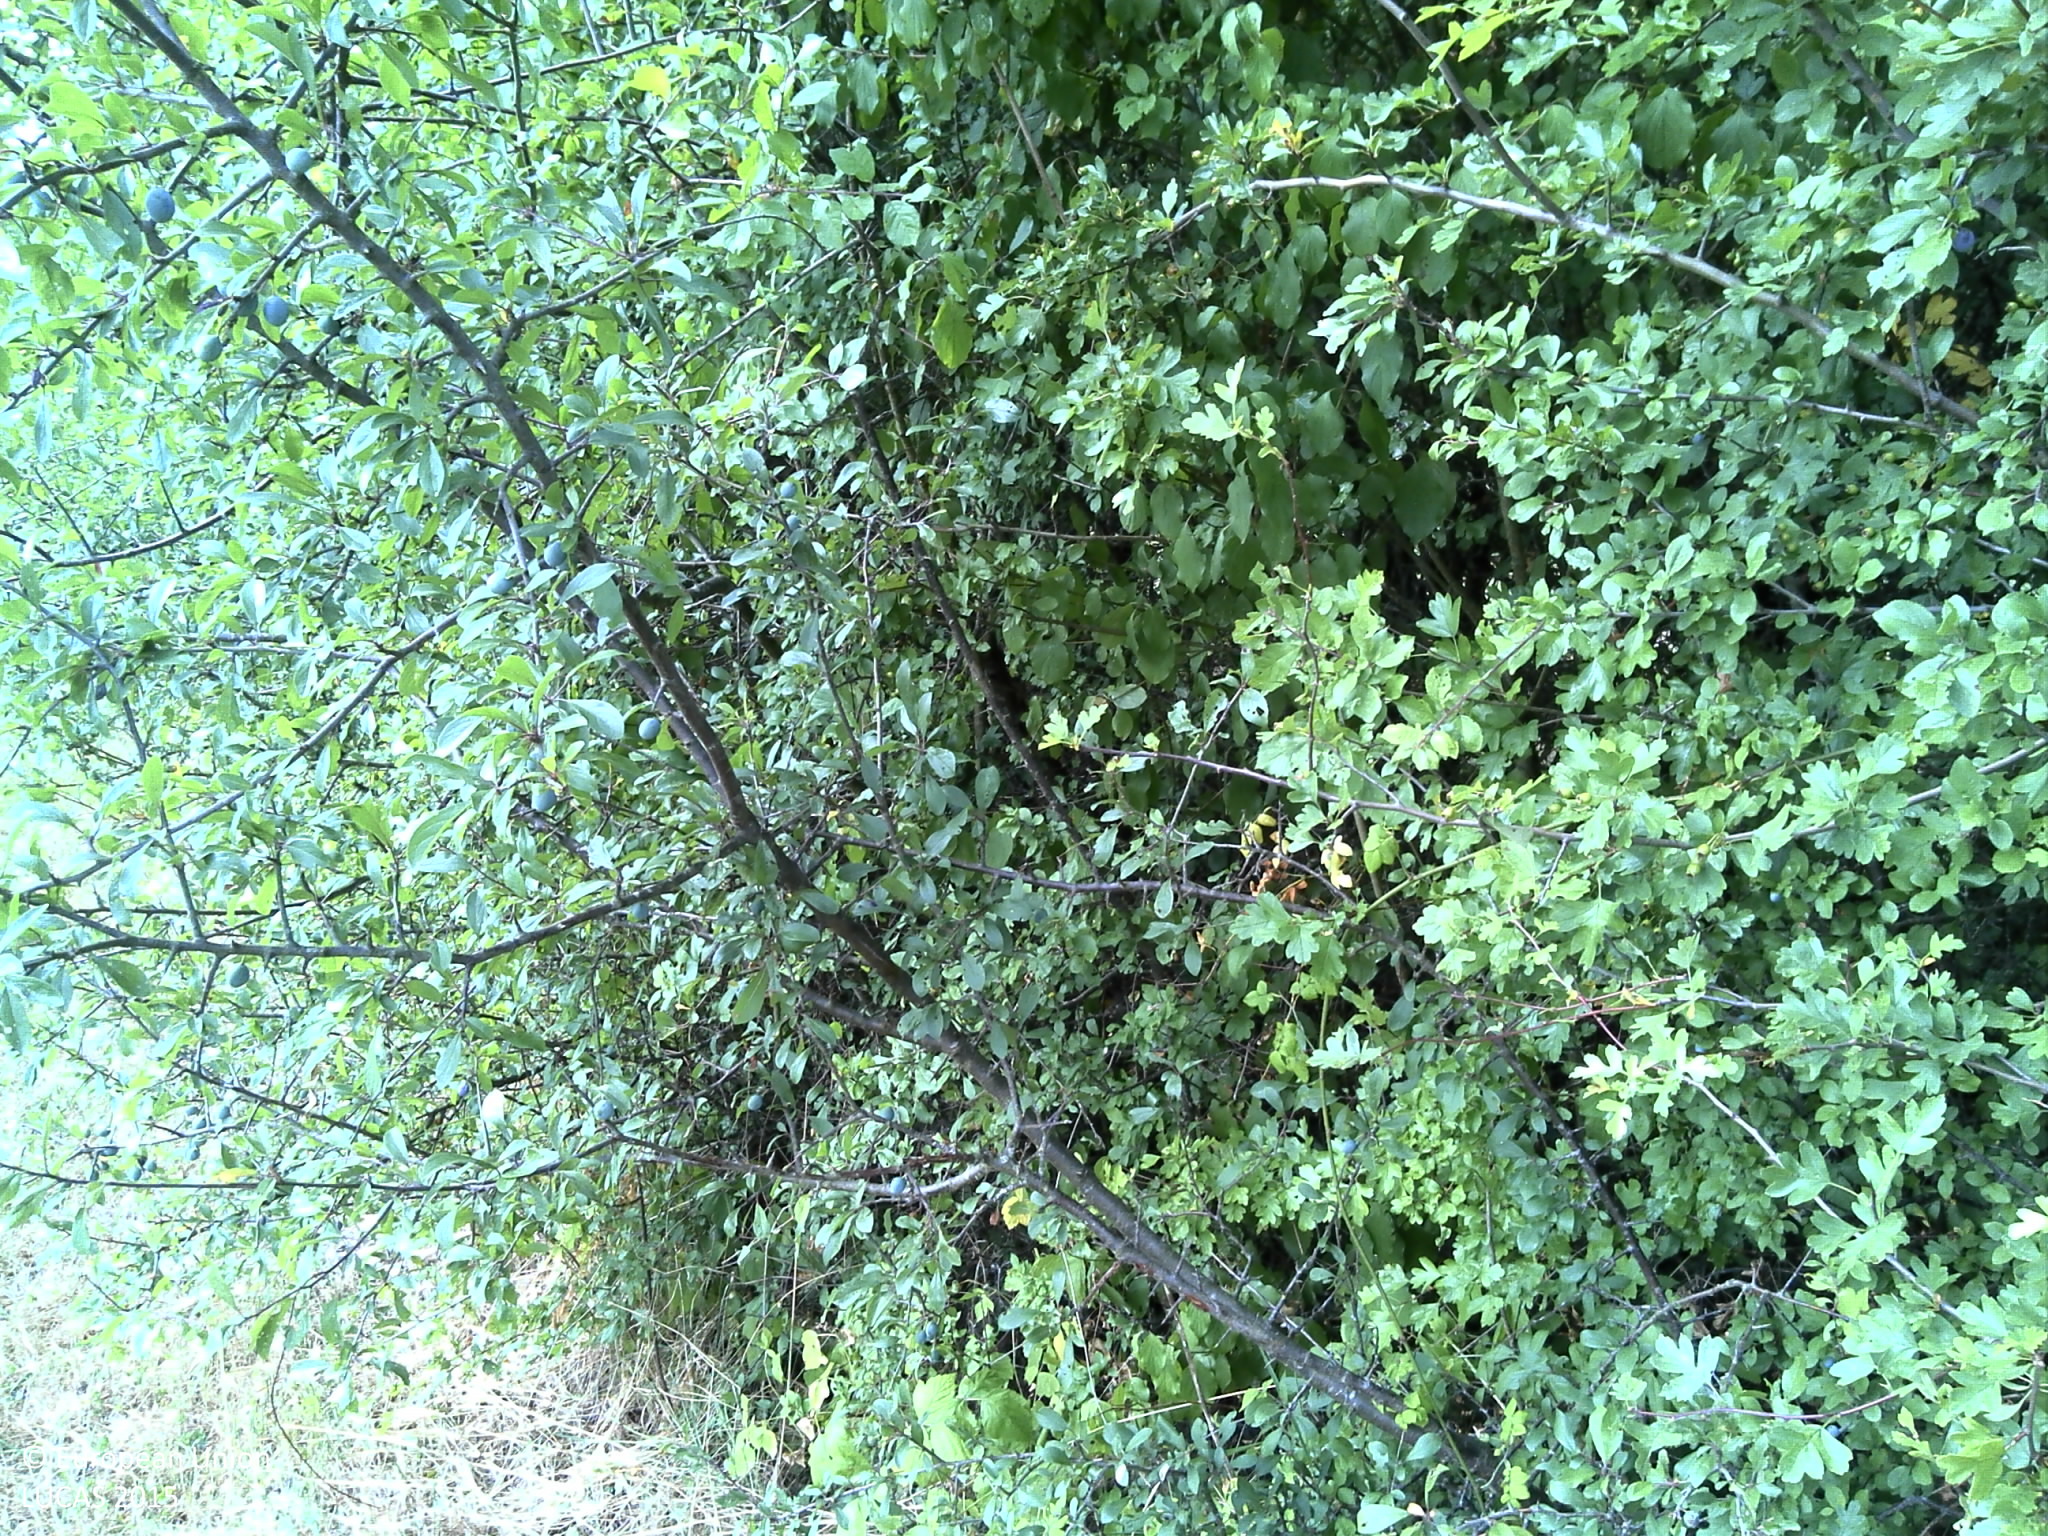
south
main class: Grassland
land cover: Grassland without tree/shrub cover
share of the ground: > 75 %
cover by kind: herbaceous plants 100 %
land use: Agriculture (excluding fallow land and kitchen gardens)
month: July
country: FR
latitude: 48.1192
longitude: 6.1183
